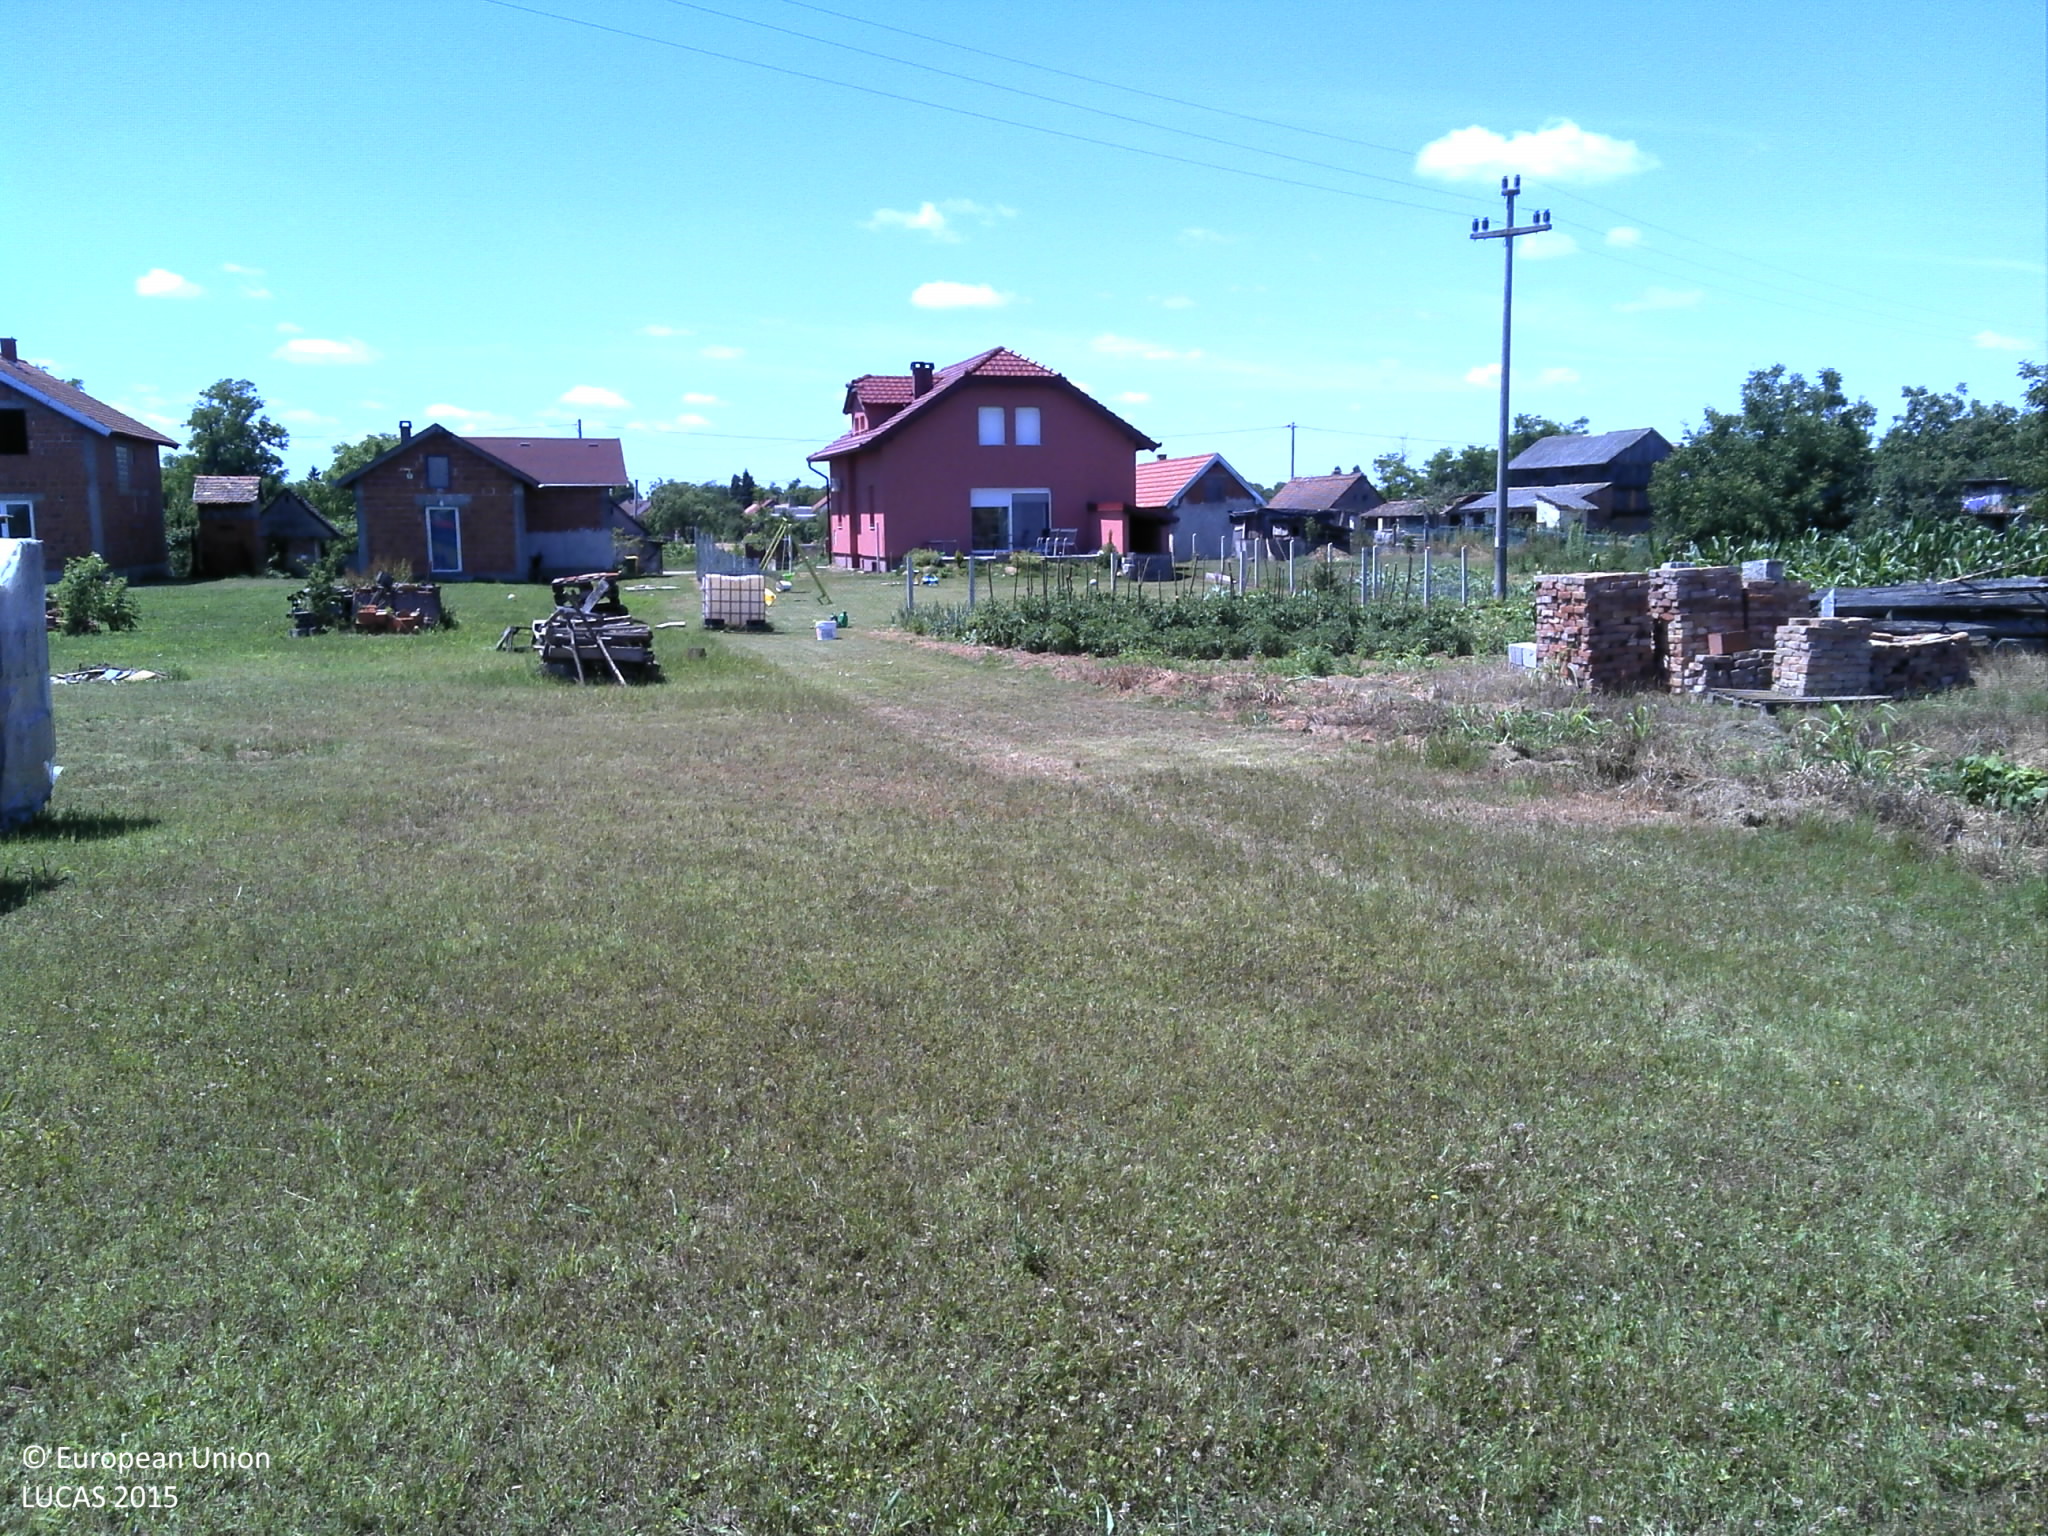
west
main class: Grassland
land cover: Grassland without tree/shrub cover
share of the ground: > 75 %
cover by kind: herbaceous plants 100 %
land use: Semi-natural and natural areas not in use
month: June
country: HR
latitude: 45.7567
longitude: 18.0659
